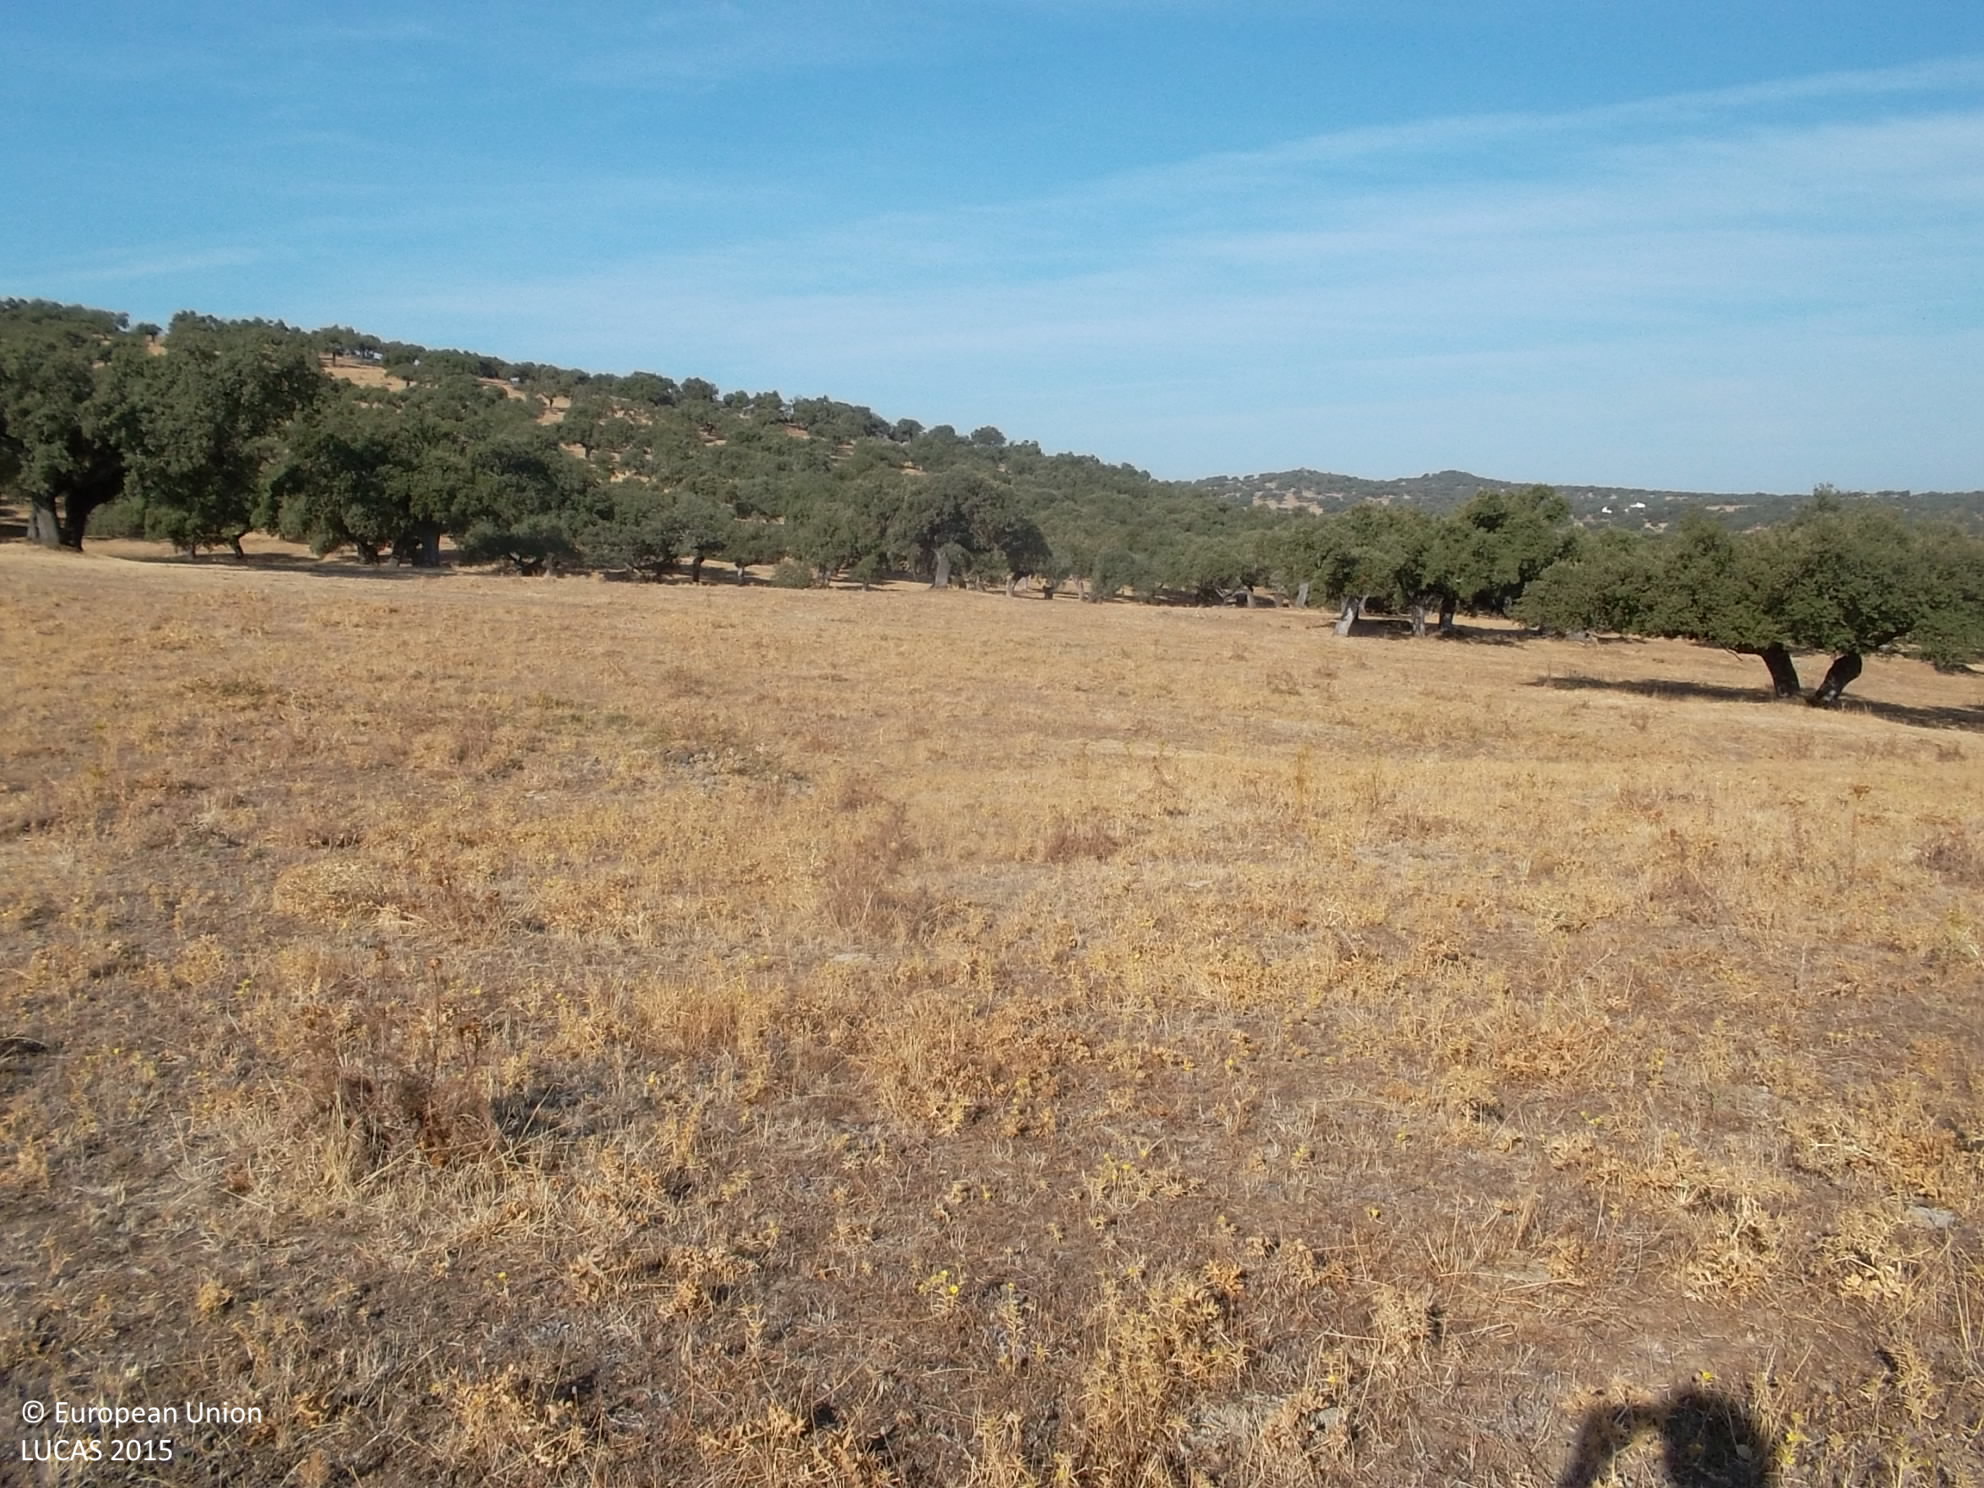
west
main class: Grassland
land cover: Grassland without tree/shrub cover
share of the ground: > 75 %
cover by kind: herbaceous plants 100 %
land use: Agriculture (excluding fallow land and kitchen gardens)
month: September
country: ES
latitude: 38.1740
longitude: -6.5197
